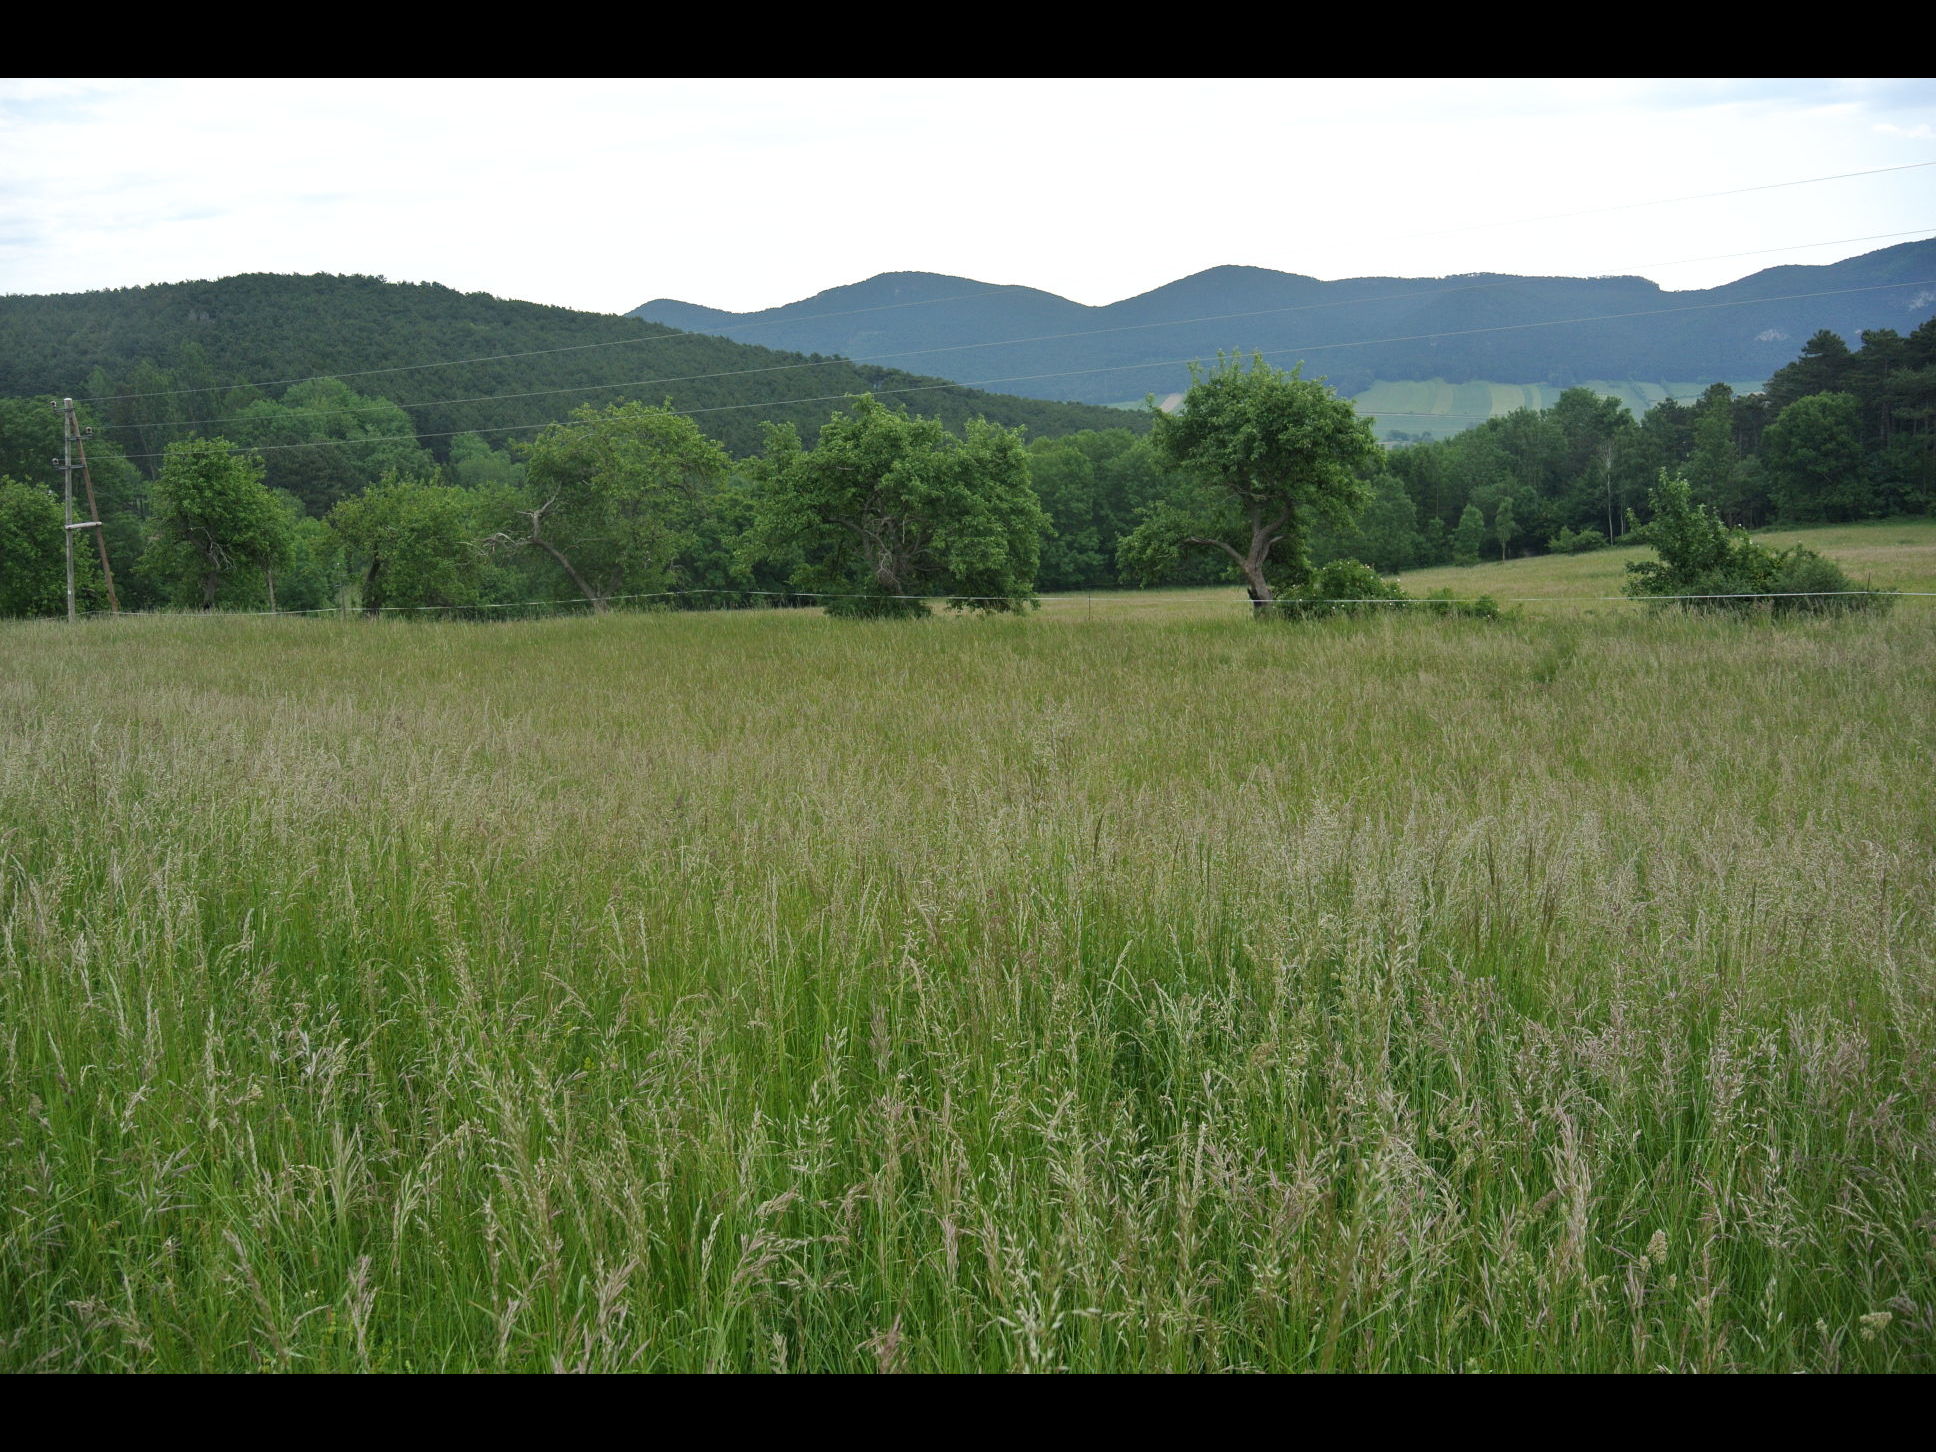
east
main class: Grassland
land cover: Grassland without tree/shrub cover
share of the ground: > 75 %
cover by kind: herbaceous plants 100 %
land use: Agriculture (excluding fallow land and kitchen gardens)
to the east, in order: Grassland without tree/shrub cover; Electric lines; Fences; Lines of trees; Grassland without tree/shrub cover; Fences; Broadleaved woodland; Grassland without tree/shrub cover; Tracks; Lines of trees; Grassland without tree/shrub cover
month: May
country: AT
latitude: 47.8390
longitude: 16.0826
